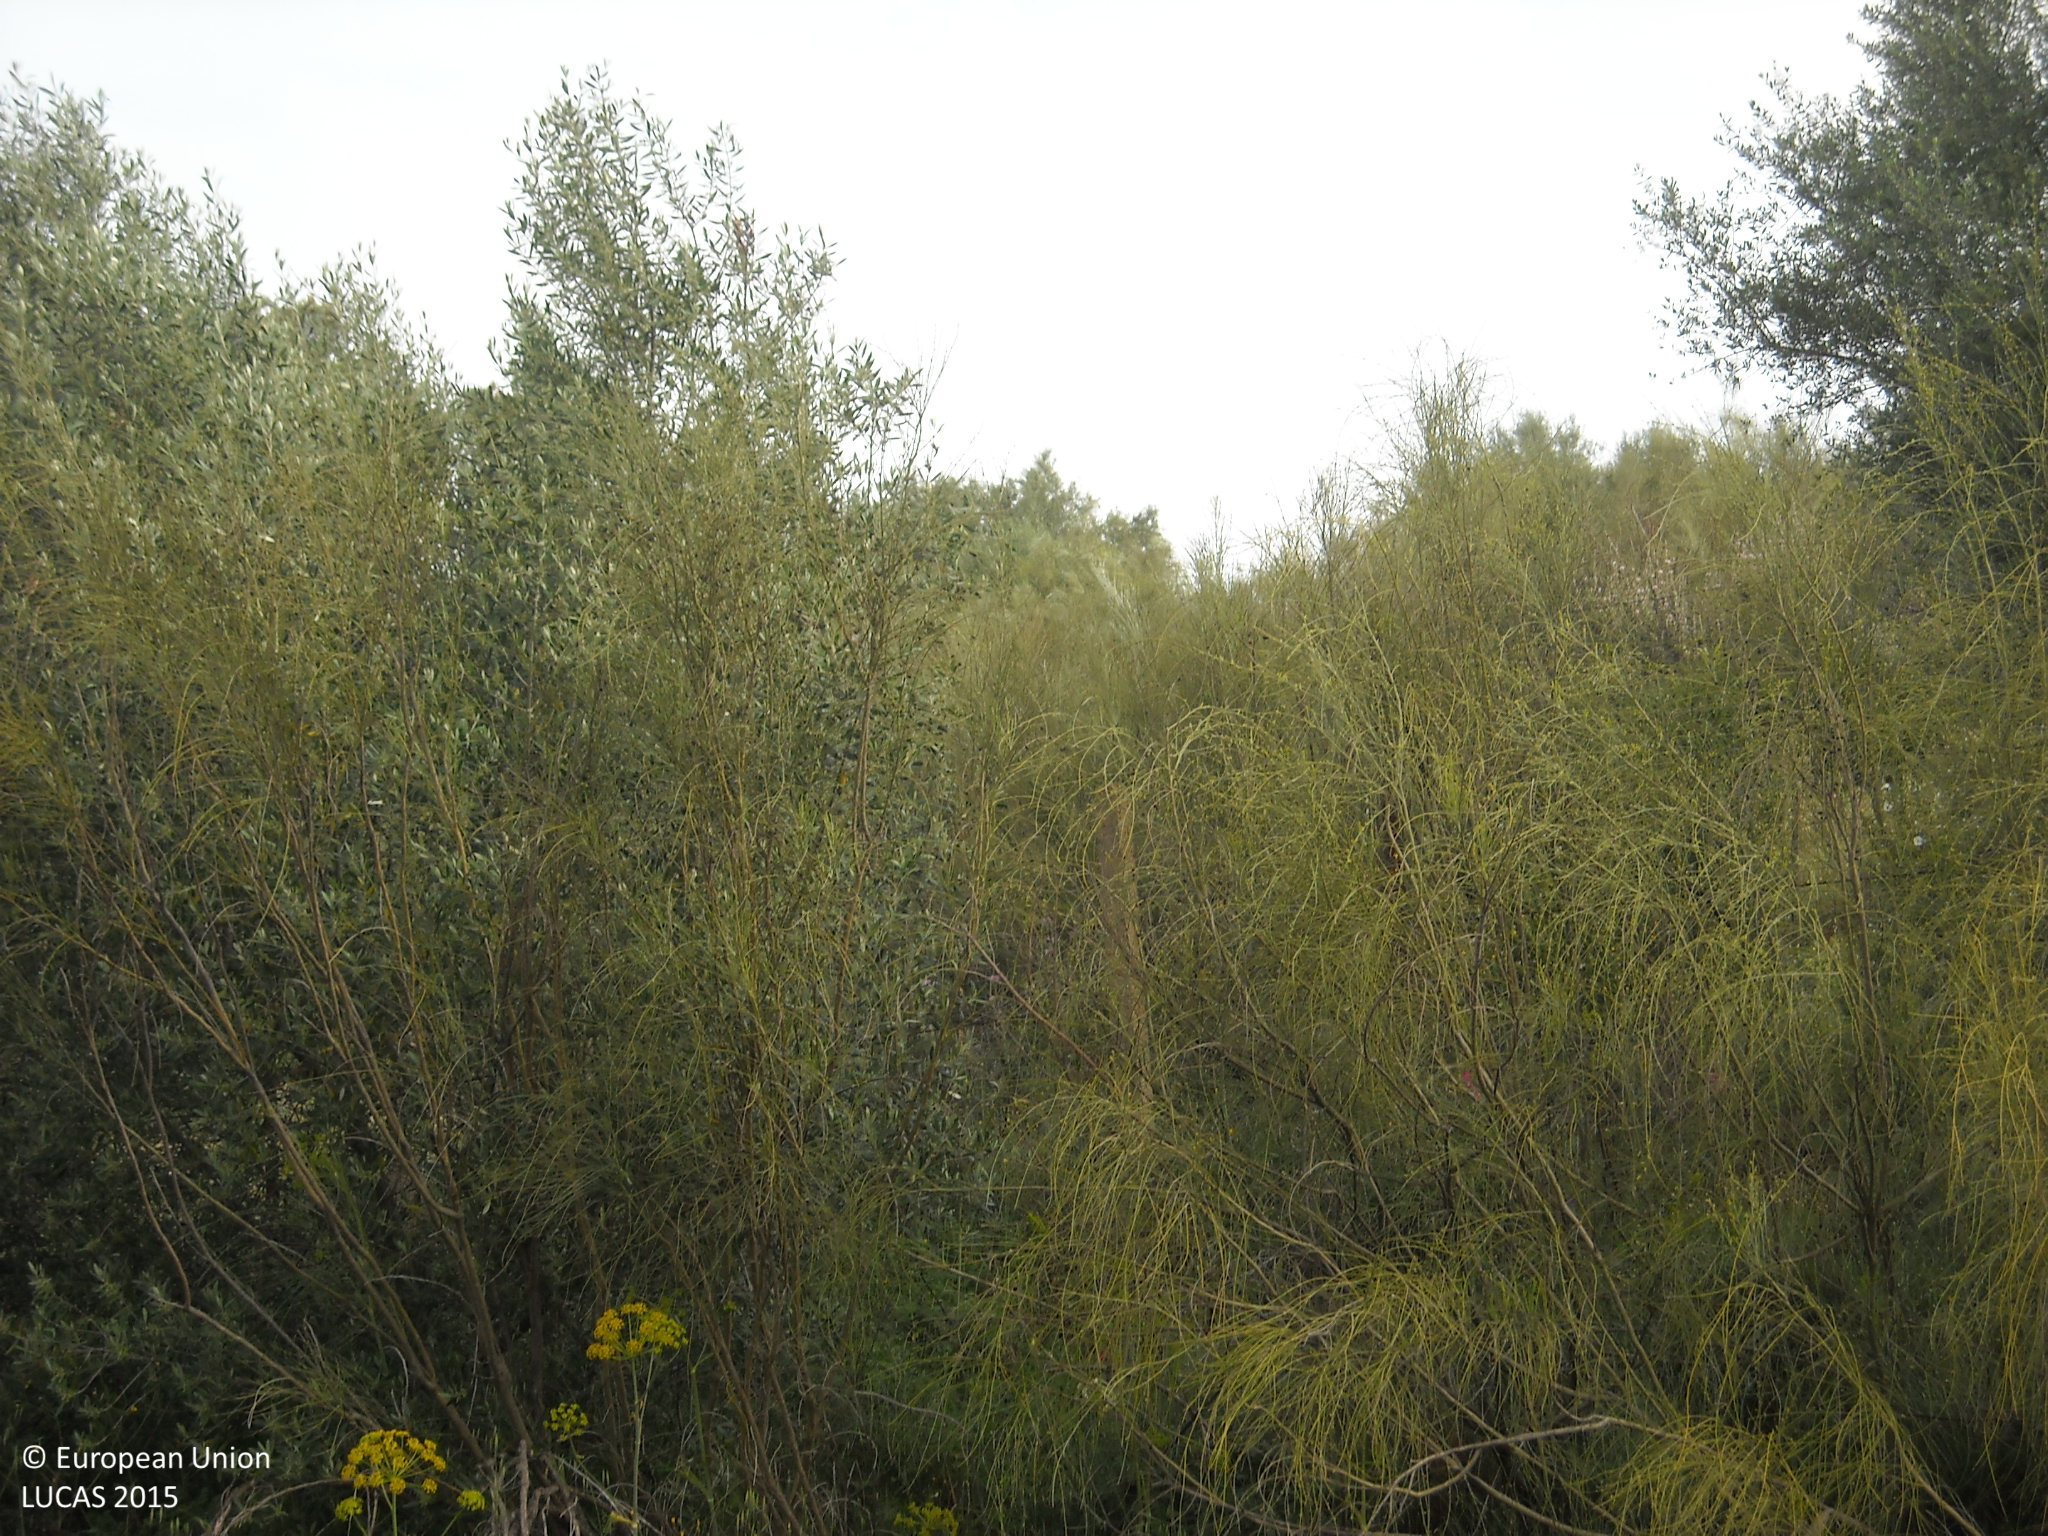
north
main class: Woodland
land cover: Broadleaved woodland
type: broadleaved evergreen forest
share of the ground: 10 - 25 %
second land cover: Grassland without tree/shrub cover
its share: > 75 %
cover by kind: herbaceous plants 70 %, broadleaved forest trees 20 %, shrubs 10 %
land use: Forestry
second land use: Agriculture (excluding fallow land and kitchen gardens)
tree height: > 5 m
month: April
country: ES
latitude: 37.7059
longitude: -6.2428
